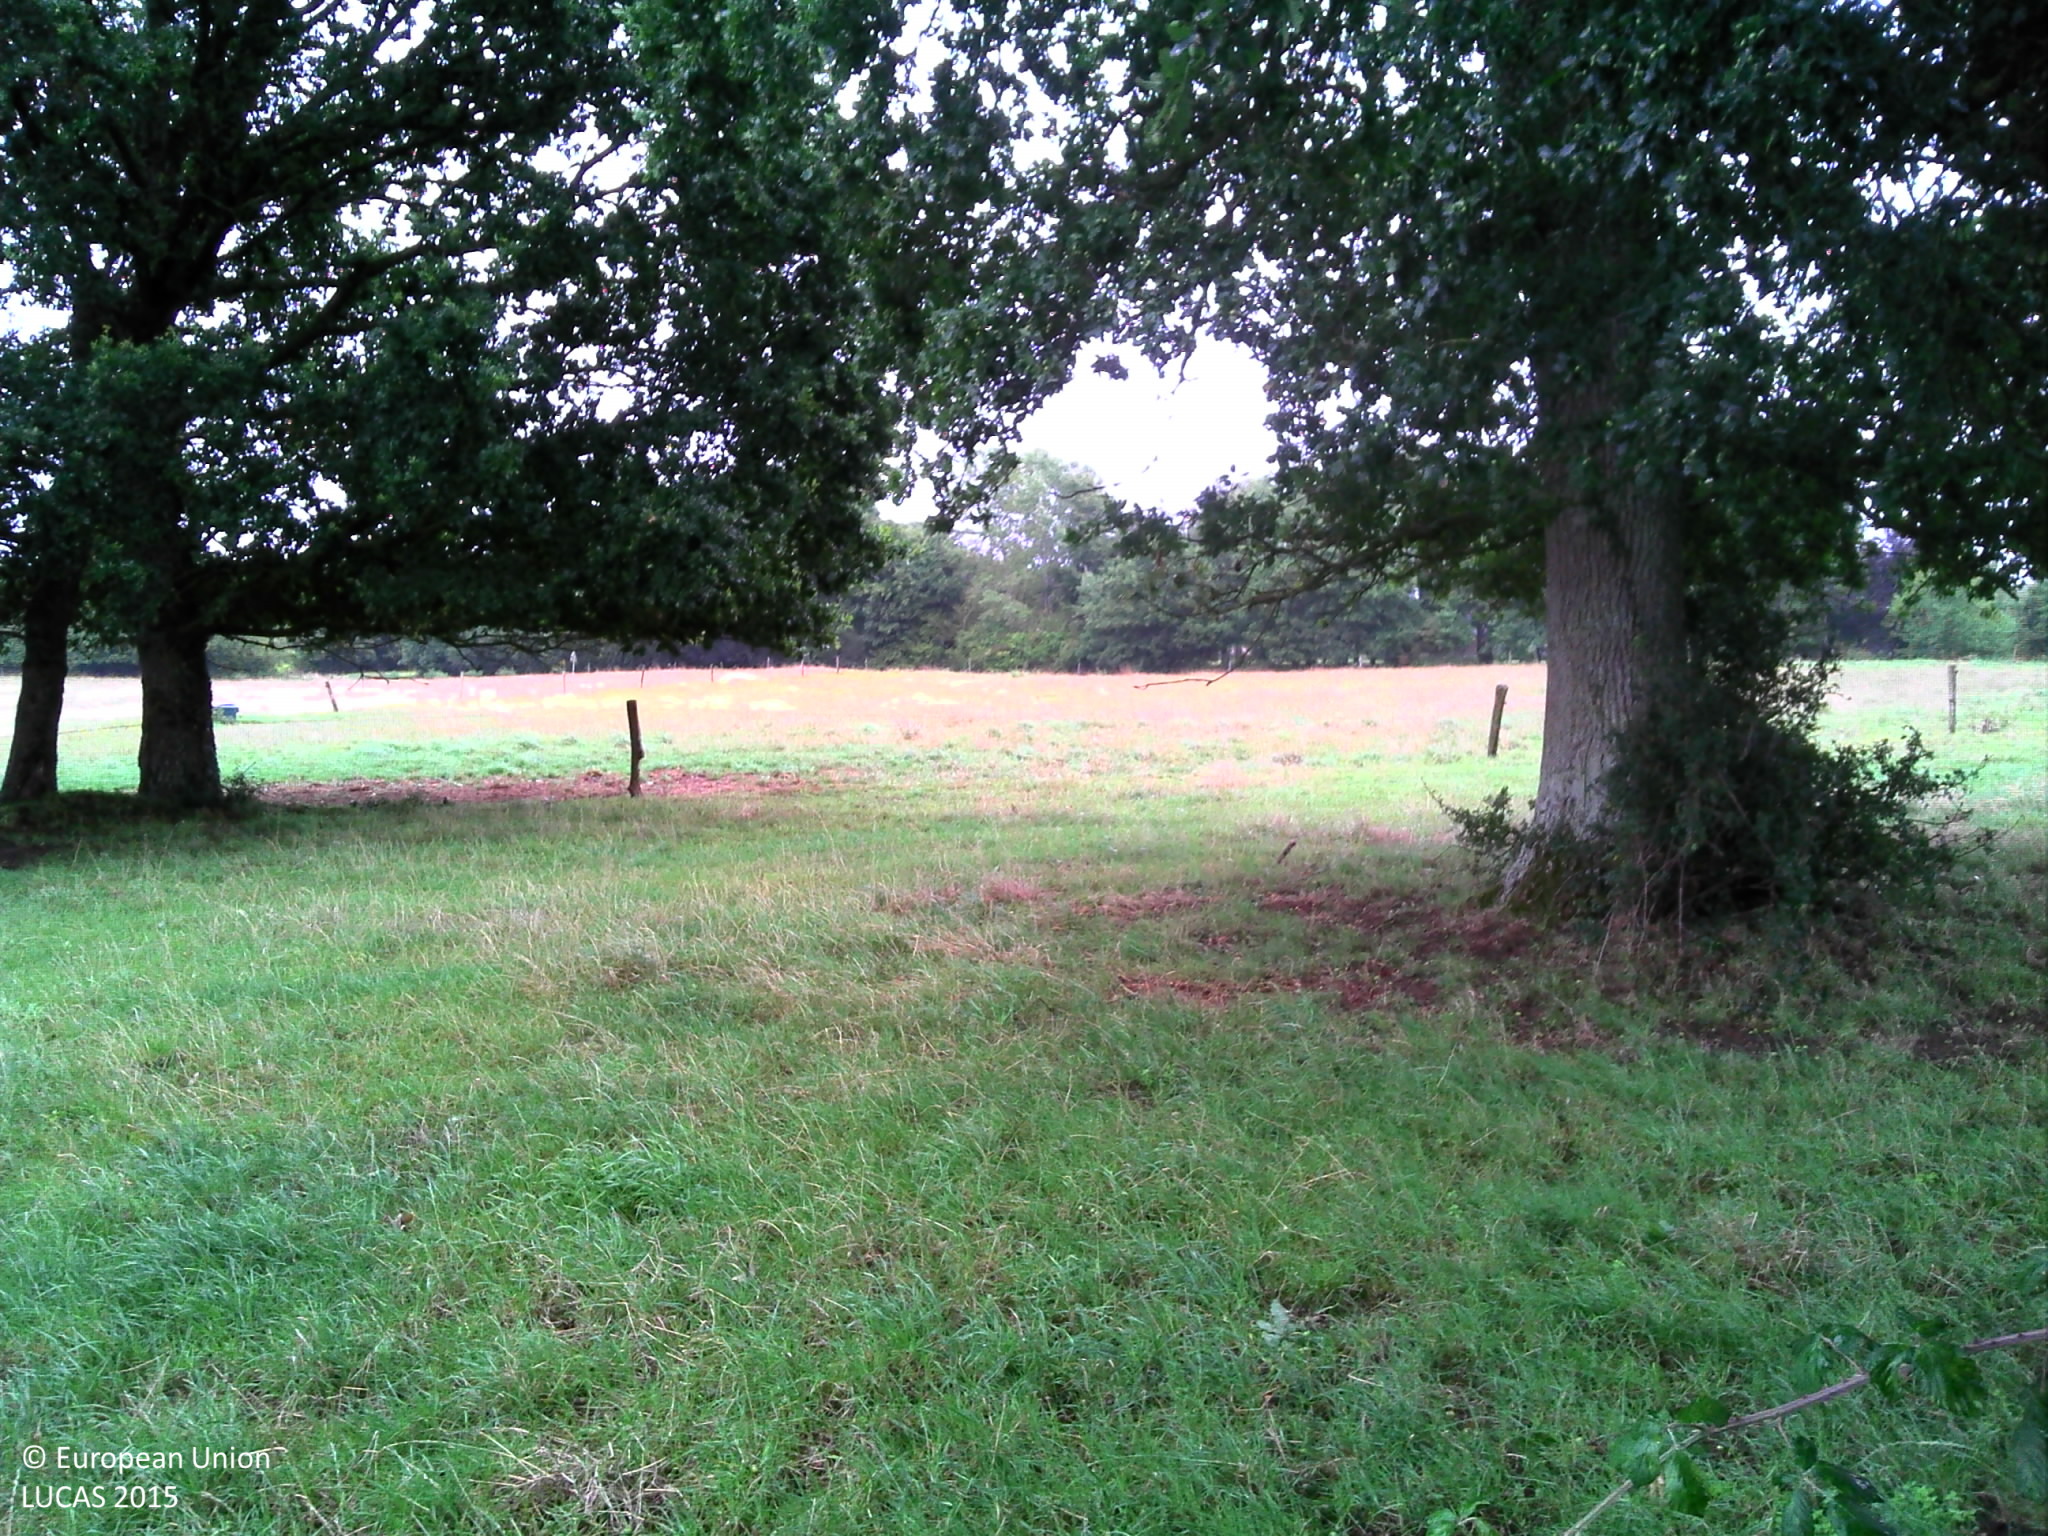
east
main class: Woodland
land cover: Broadleaved woodland
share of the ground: > 75 %
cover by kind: herbaceous plants 80 %, broadleaved forest trees 10 %, unconsolidated bare surface 10 %
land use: Semi-natural and natural areas not in use
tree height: > 5 m
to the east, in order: Broadleaved woodland; Grassland with sparse tree/shrub cover; Fences; Grassland without tree/shrub cover; Fences; Ditches and canals; Grass margins; Paved roads, cycling and walking lanes; Grass margins; Ditches and canals; Broadleaved woodland; Grassland without tree/shrub cover; Artificial constructions in urban areas
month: August
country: FR
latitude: 48.3628
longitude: -2.0261
